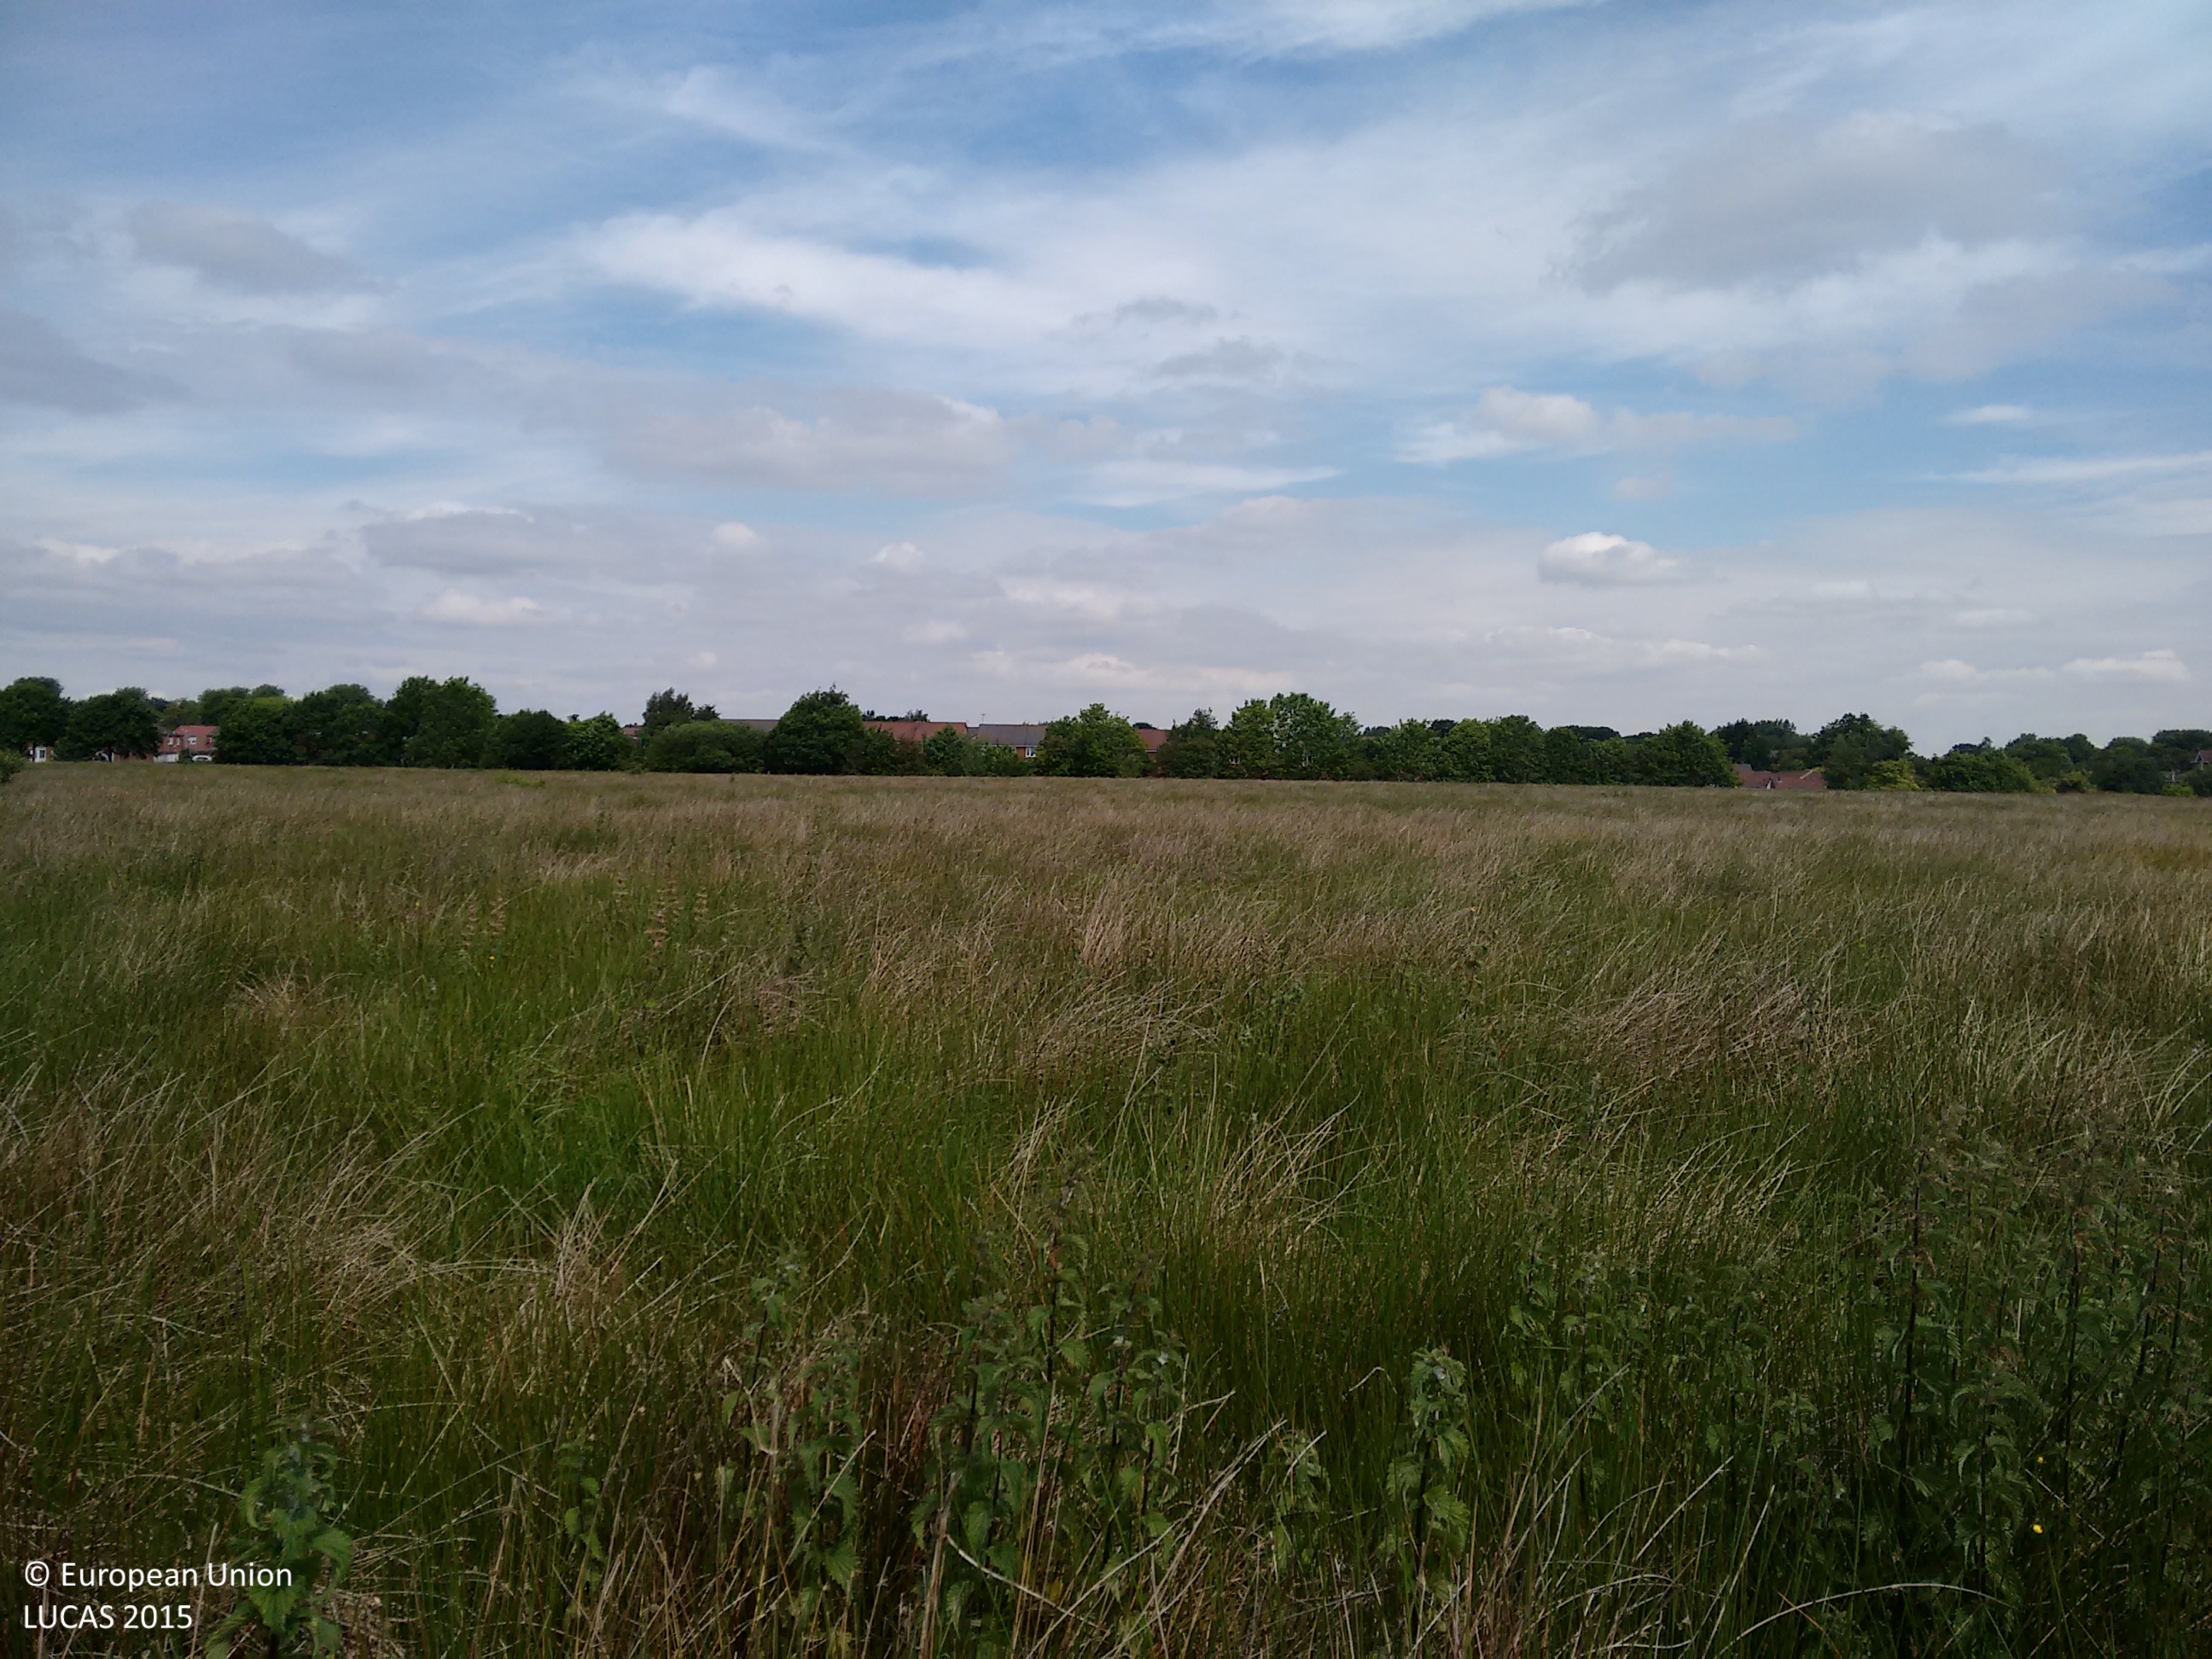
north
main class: Grassland
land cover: Grassland without tree/shrub cover
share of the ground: > 75 %
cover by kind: herbaceous plants 100 %
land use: Semi-natural and natural areas not in use
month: June
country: GB
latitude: 53.5418
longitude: -2.4231
